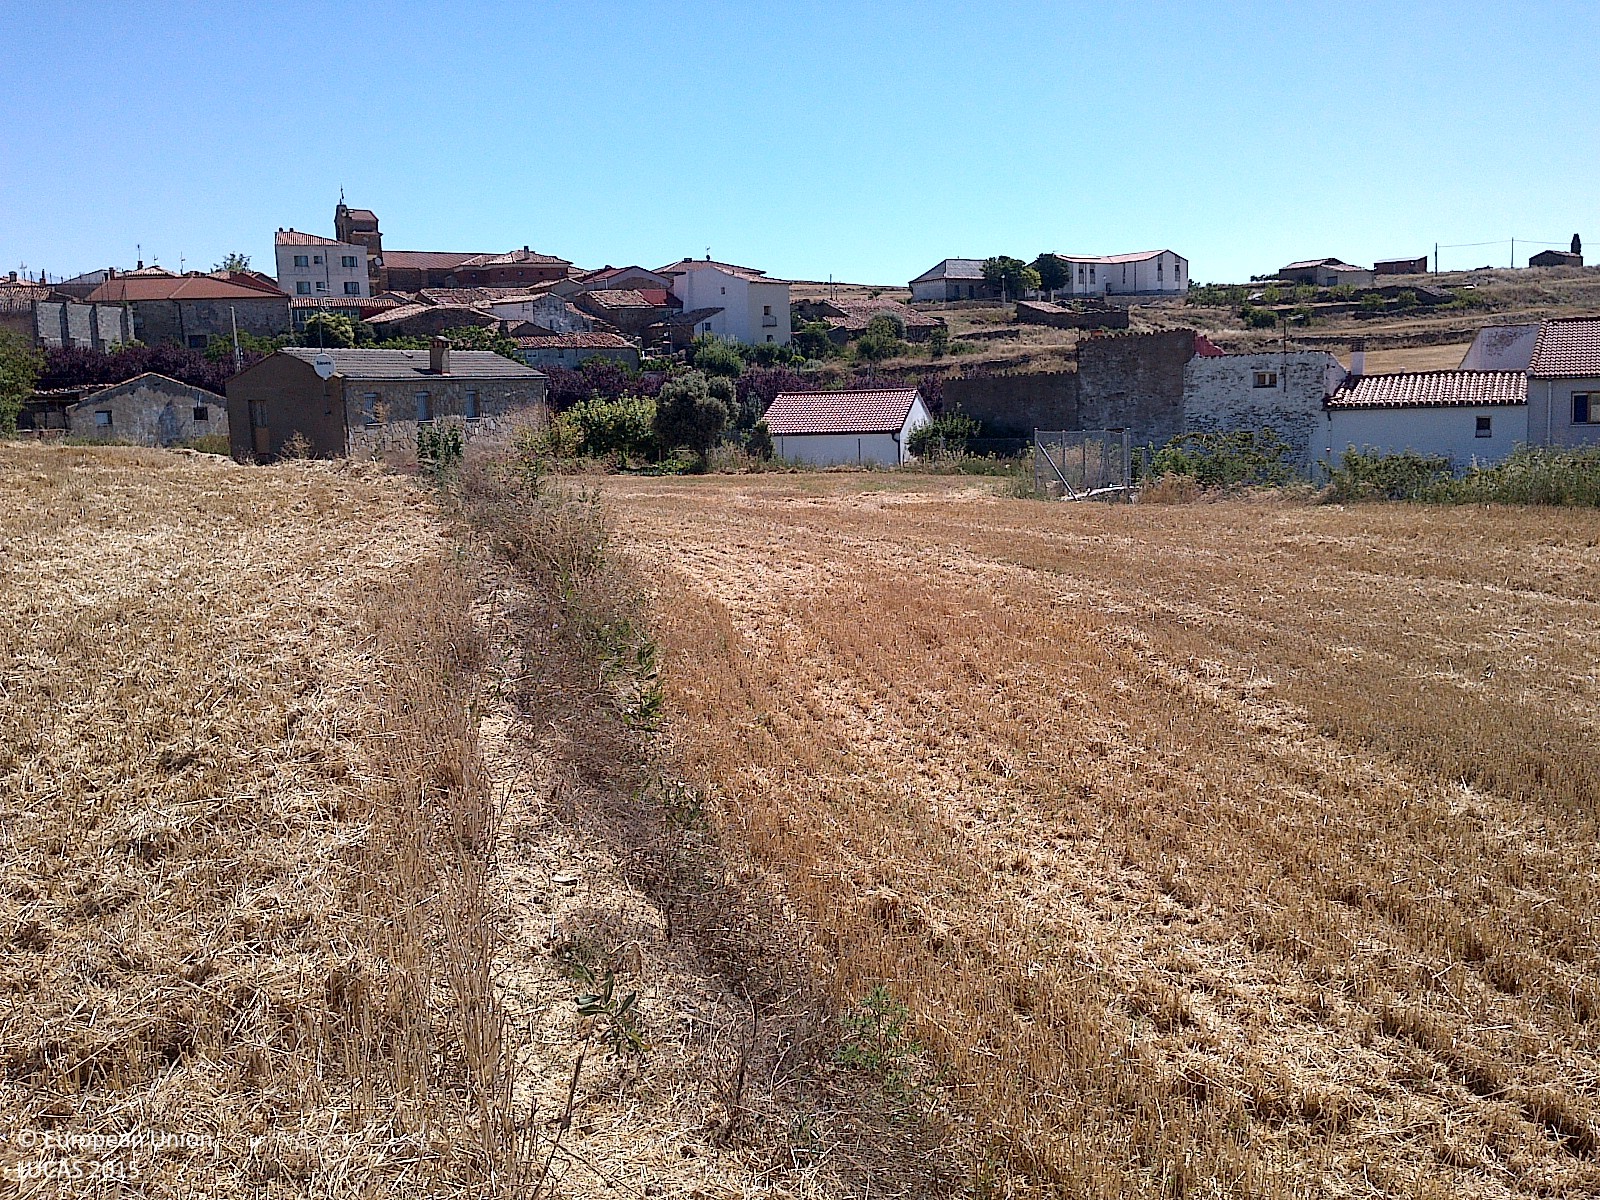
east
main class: Cropland
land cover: Common wheat
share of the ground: < 10 %
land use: Agriculture (excluding fallow land and kitchen gardens)
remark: Harvested field
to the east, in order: Common wheat; Dry stone walls; Other fruit trees and berries; Artificial constructions in urban areas; Dry stone walls; Spontaneously vegetated surfaces; Managed hedges; Ditches and canals; Managed hedges; Spontaneously vegetated surfaces; Dry stone walls; Barley; Grassland with sparse tree/shrub cover; Barley; Grassland with sparse tree/shrub cover; Dry stone walls; Grassland without tree/shrub cover; Artificial constructions in urban areas; Grassland with sparse tree/shrub cover; Paved roads, cycling and walking lanes; Artificial constructions in urban areas
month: July
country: ES
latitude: 41.9341
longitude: -2.1813
